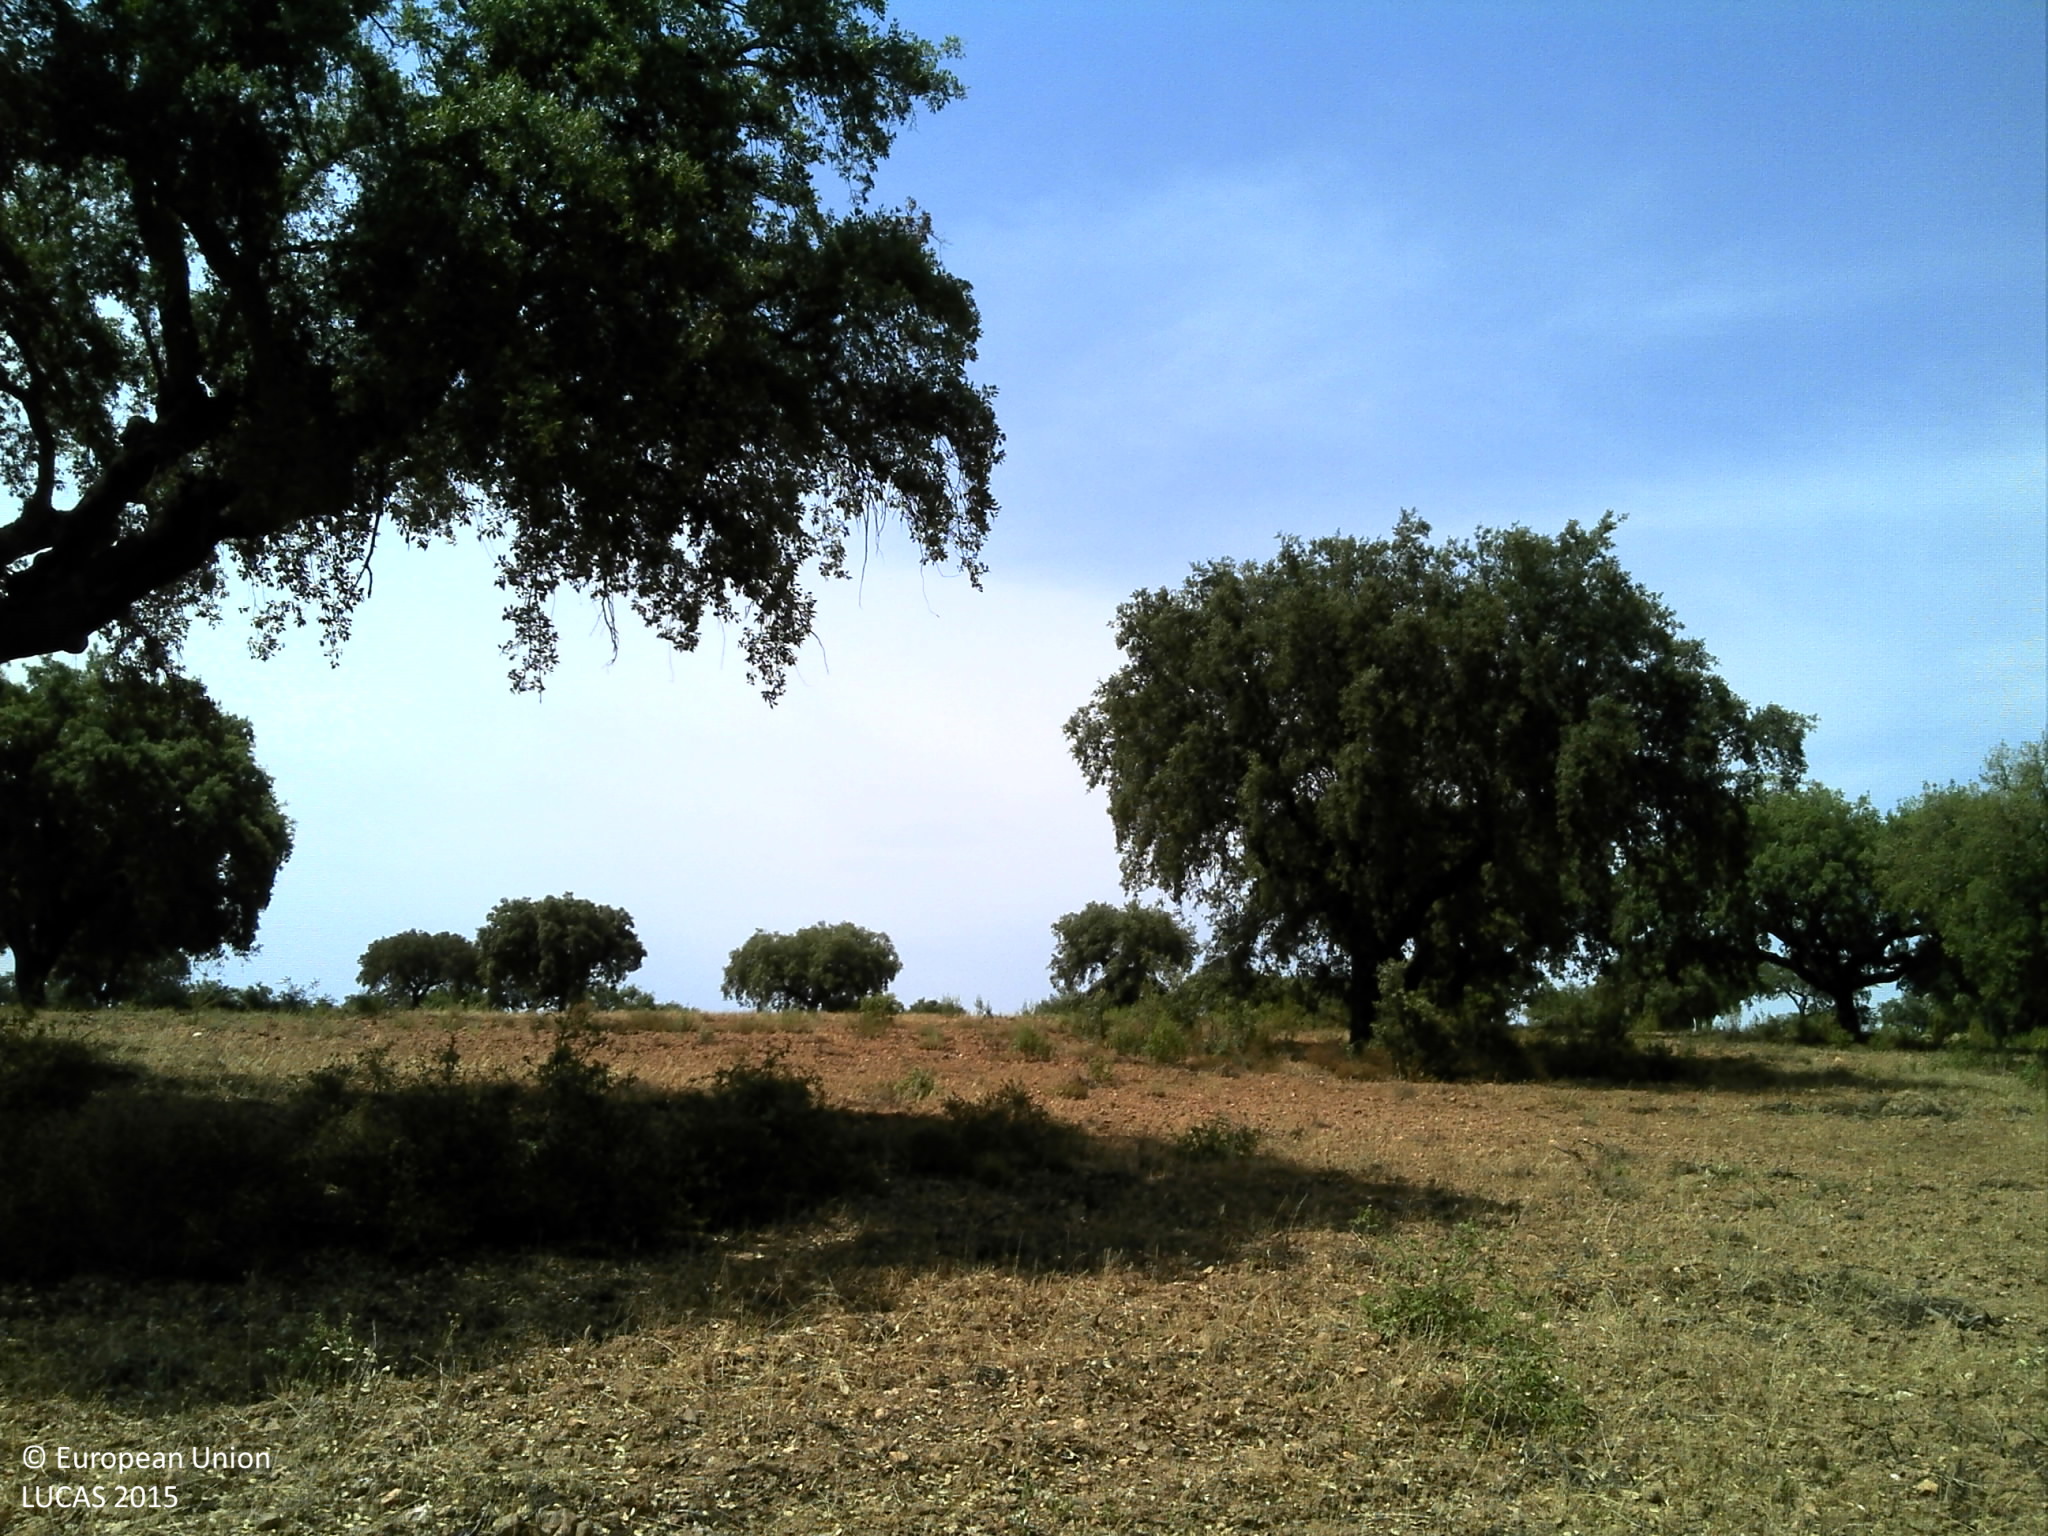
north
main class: Woodland
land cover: Broadleaved woodland
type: broadleaved evergreen forest
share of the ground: 10 - 25 %
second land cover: Grassland without tree/shrub cover
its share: 10 - 25 %
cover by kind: unconsolidated bare surface 70 %, broadleaved forest trees 15 %, herbaceous plants 15 %
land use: Forestry
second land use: Agriculture (excluding fallow land and kitchen gardens)
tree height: > 5 m
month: June
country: PT
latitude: 38.6268
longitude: -7.6902
